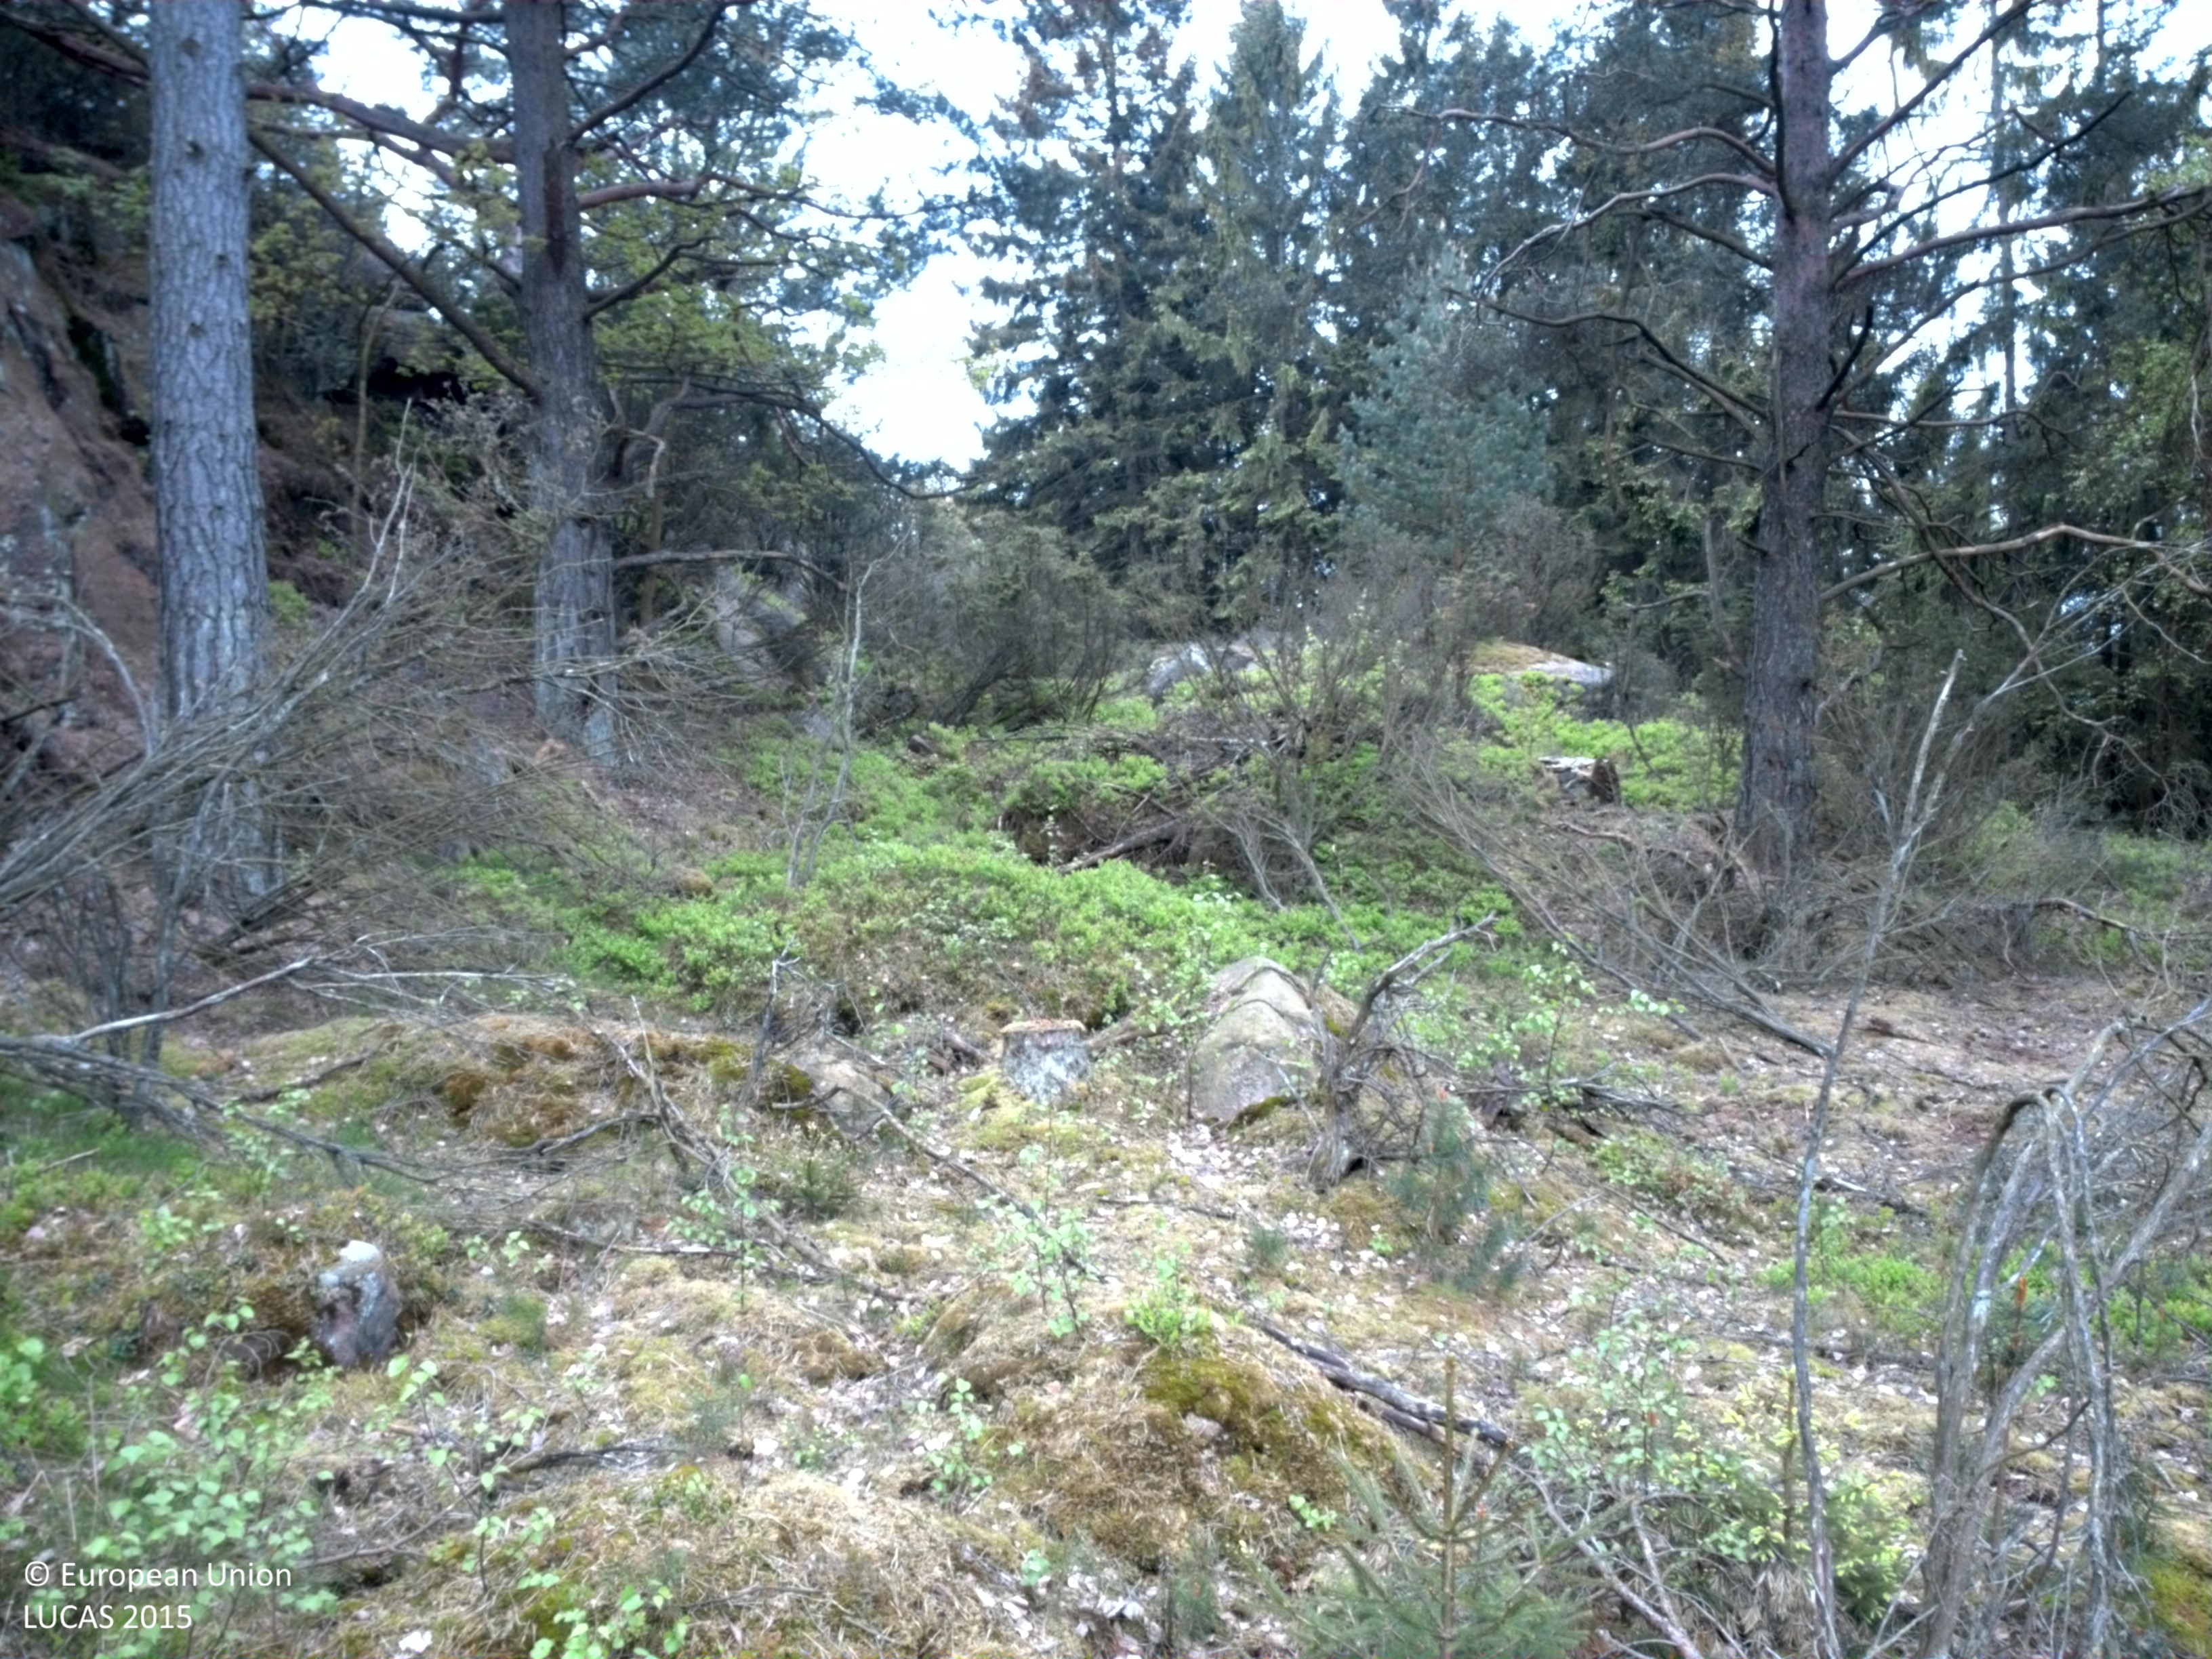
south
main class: Shrubland
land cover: Shrubland with sparse tree cover
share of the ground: > 75 %
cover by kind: herbaceous plants 55 %, shrubs 40 %, coniferous forest trees 5 %
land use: Forestry
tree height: < 5 m
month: May
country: SE
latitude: 57.7734
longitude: 11.9638
